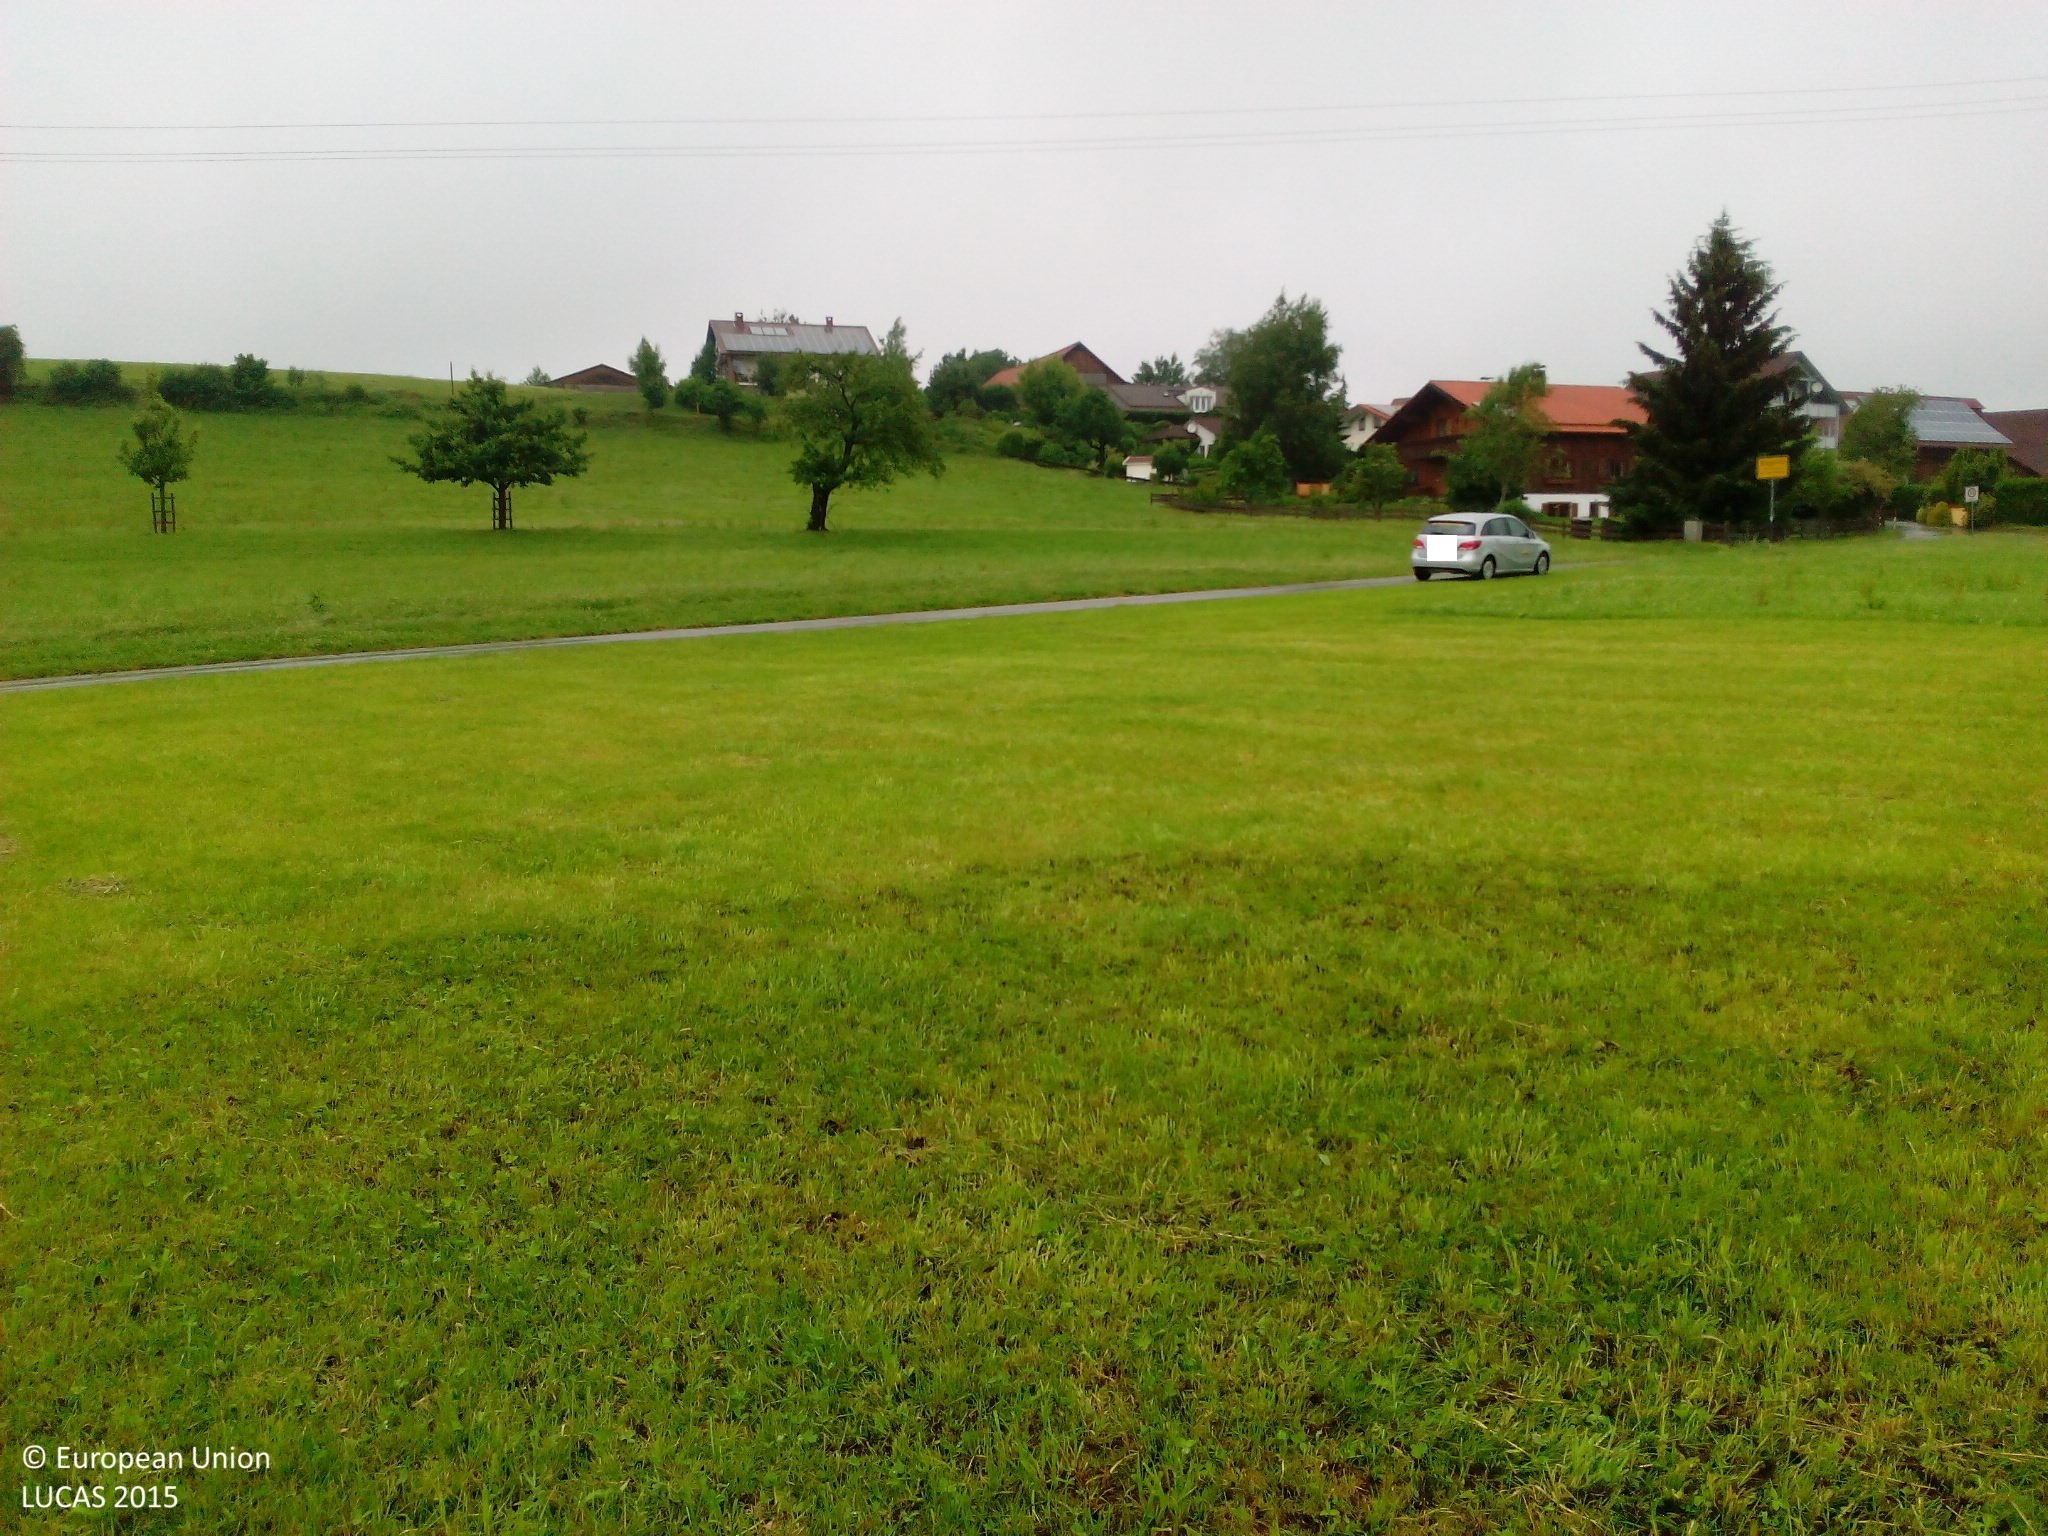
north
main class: Grassland
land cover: Grassland without tree/shrub cover
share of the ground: > 75 %
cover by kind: herbaceous plants 100 %
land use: Agriculture (excluding fallow land and kitchen gardens)
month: June
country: DE
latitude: 47.6655
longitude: 9.8536
